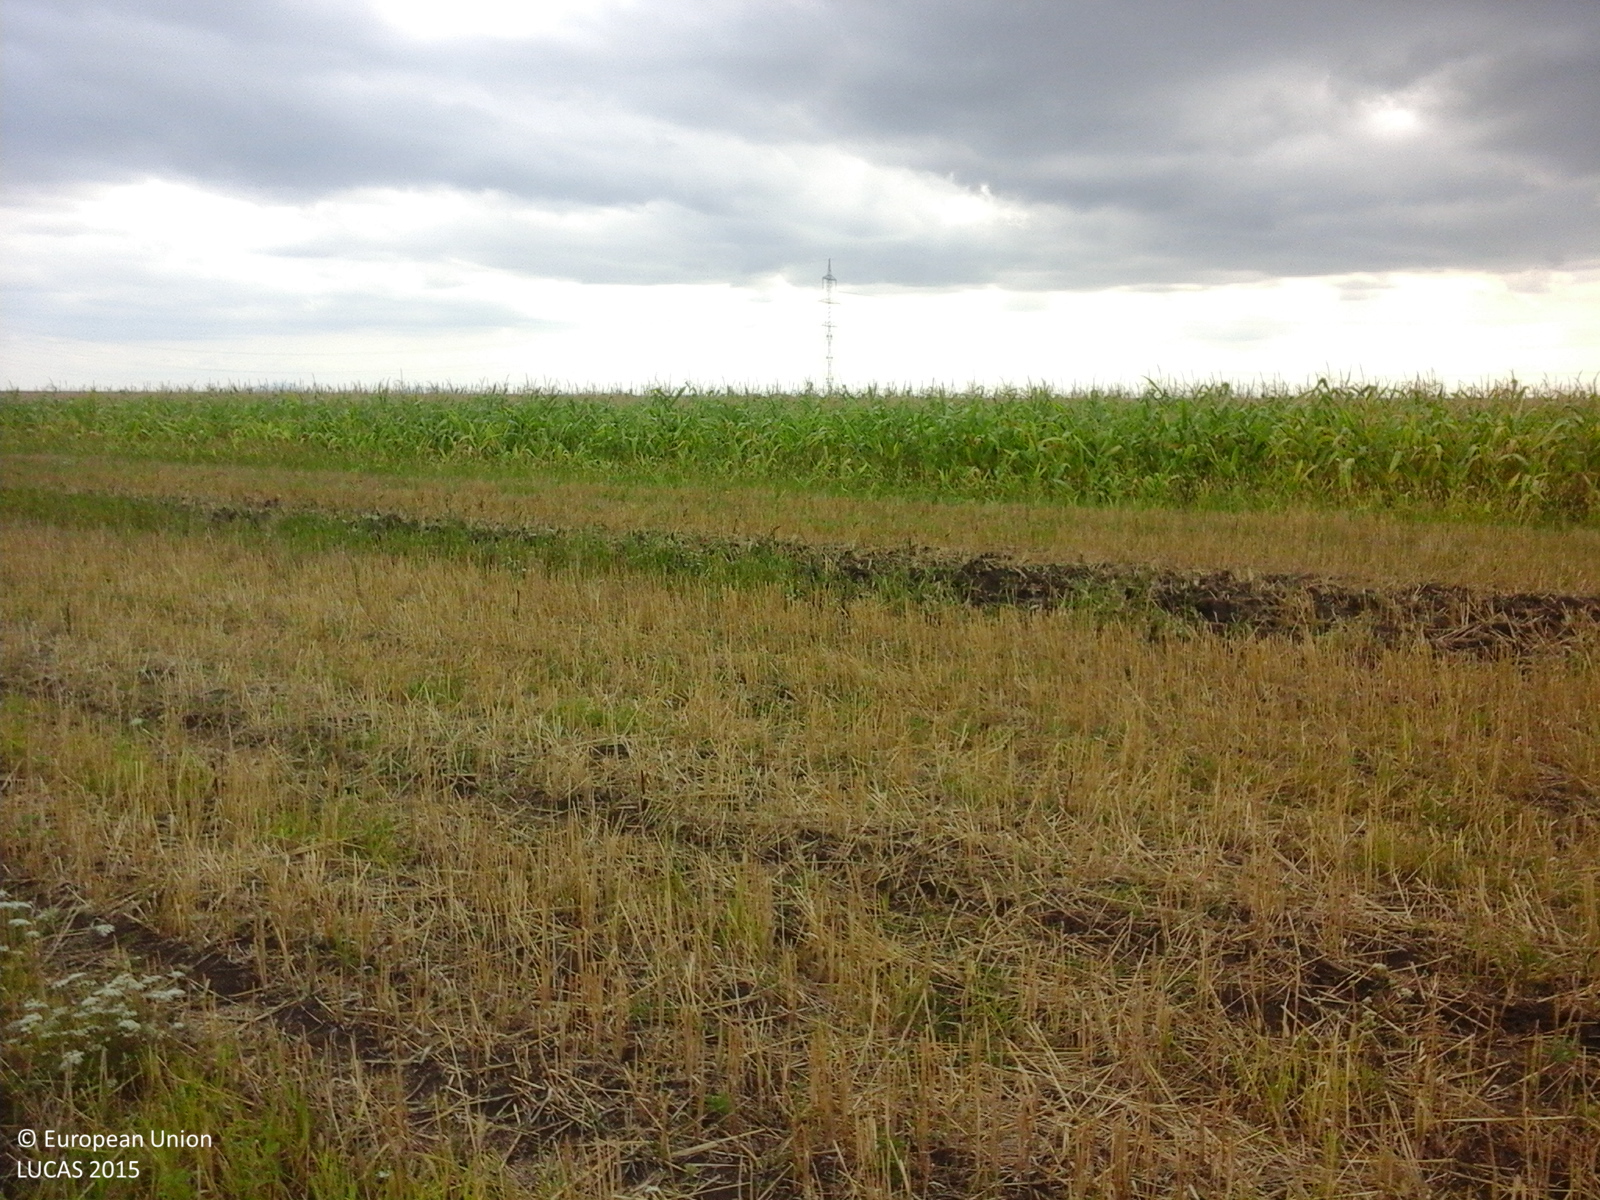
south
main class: Cropland
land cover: Common wheat
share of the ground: 10 - 25 %
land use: Agriculture (excluding fallow land and kitchen gardens)
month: August
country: RO
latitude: 45.5117
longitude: 21.4885
